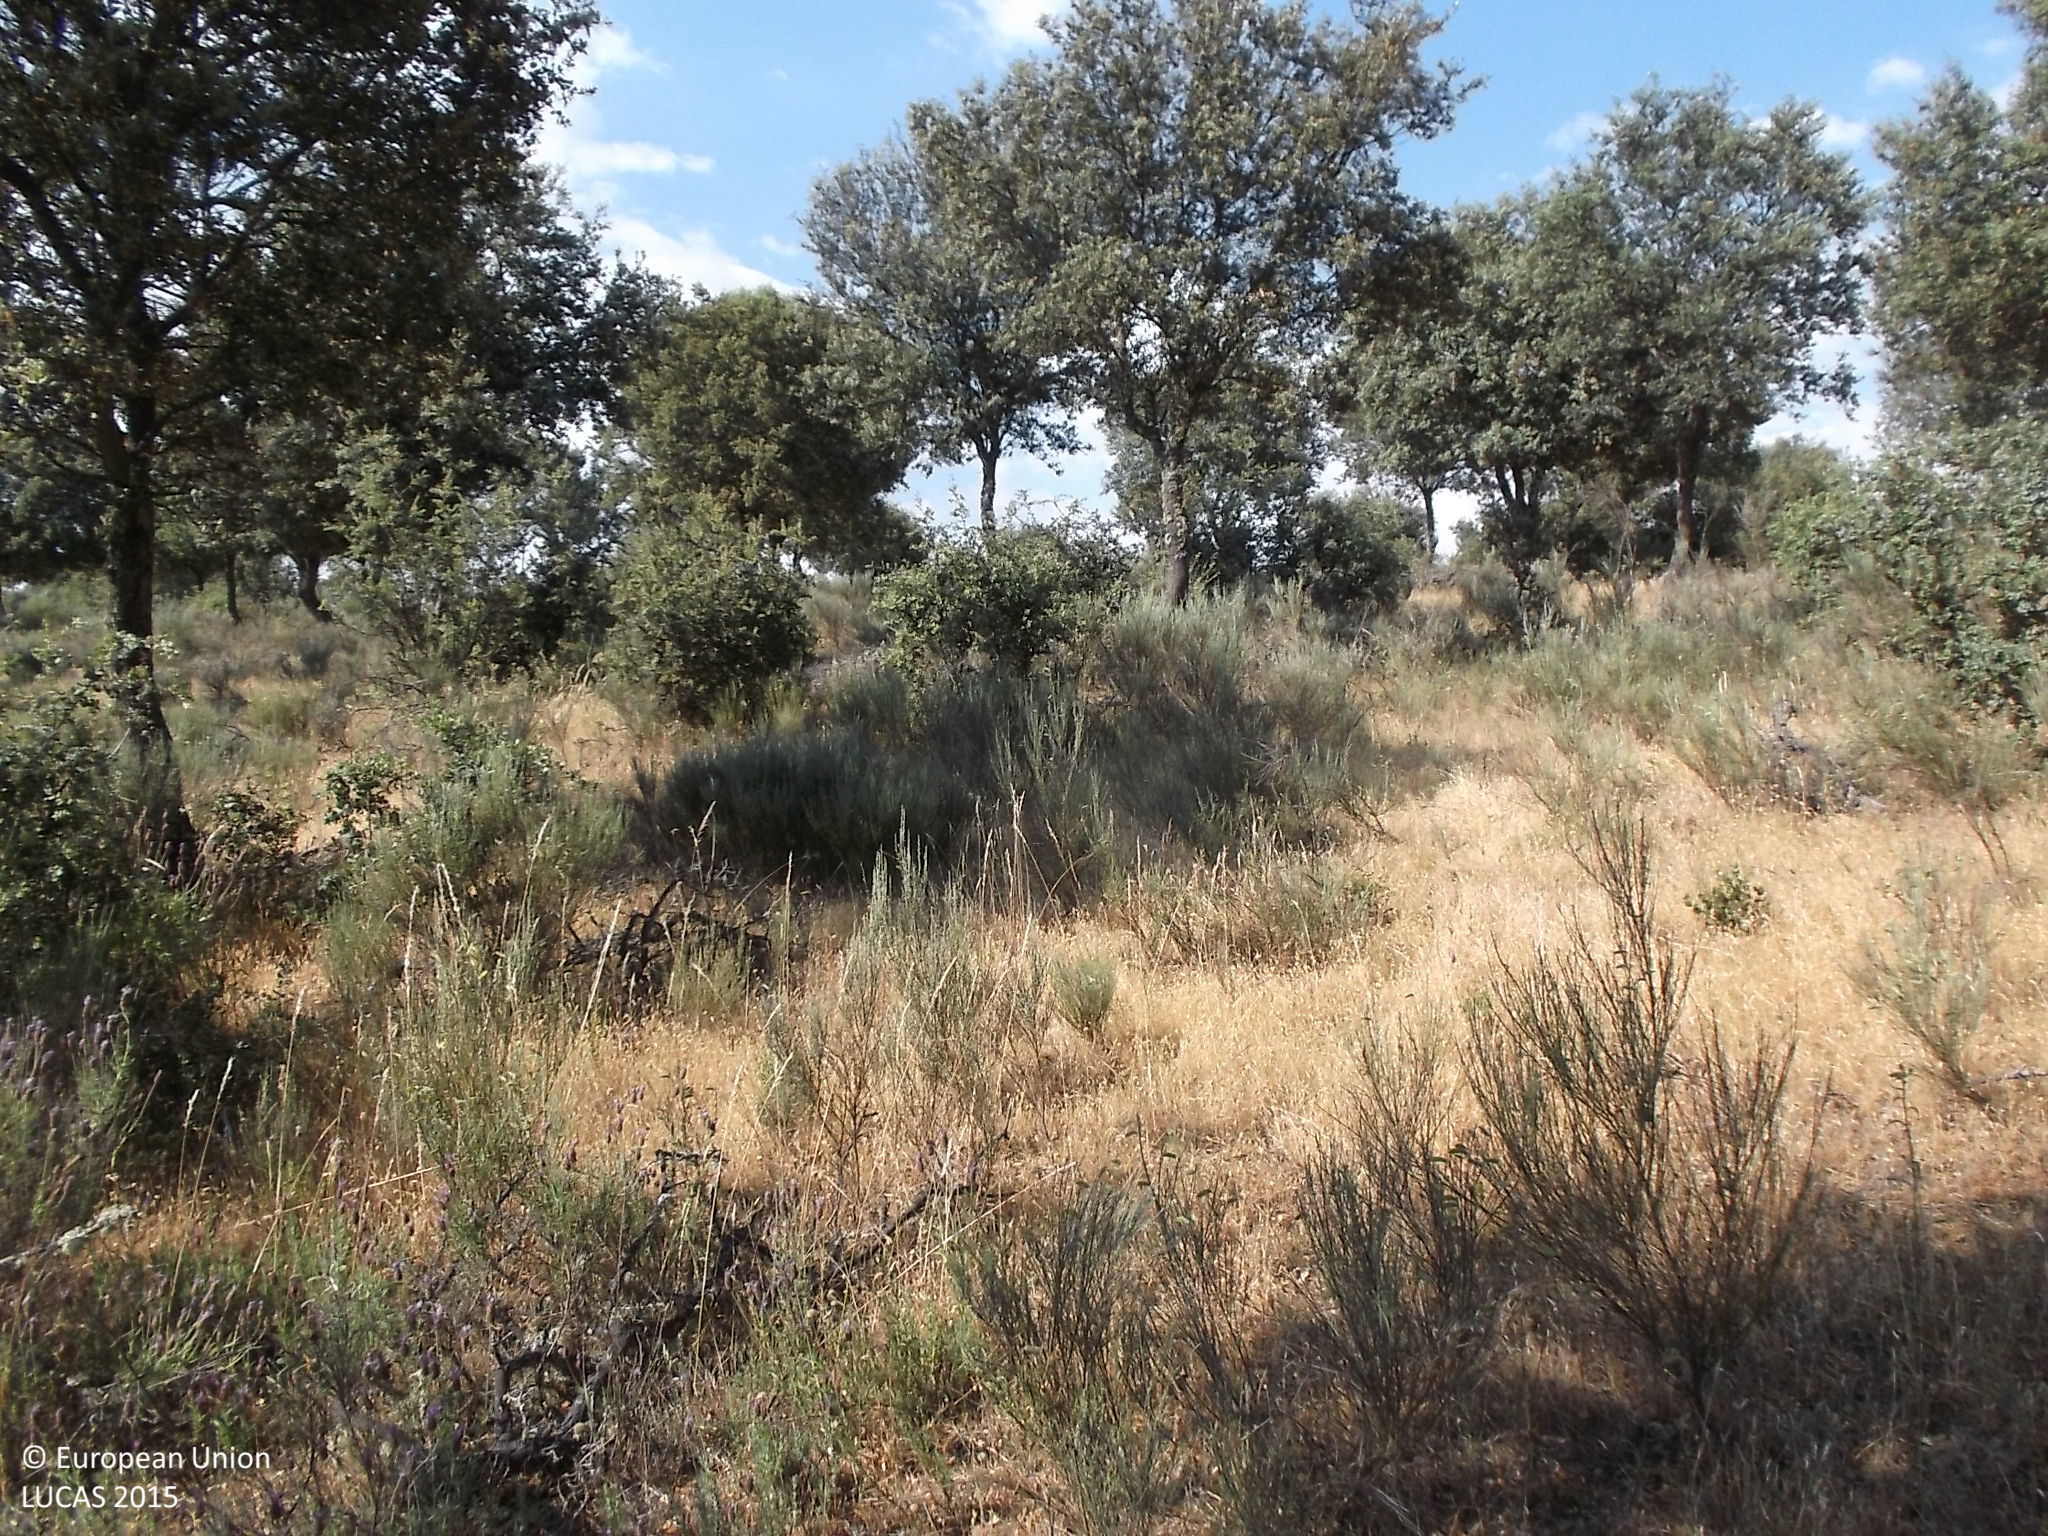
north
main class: Woodland
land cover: Broadleaved woodland
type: thermophilous deciduous forest
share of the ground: 10 - 25 %
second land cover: Shrubland without tree cover
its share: 50 - 75 %
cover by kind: shrubs 50 %, herbaceous plants 35 %, broadleaved forest trees 15 %
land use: Forestry
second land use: Agriculture (excluding fallow land and kitchen gardens)
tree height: > 5 m
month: June
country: ES
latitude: 40.8604
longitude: -6.4276
